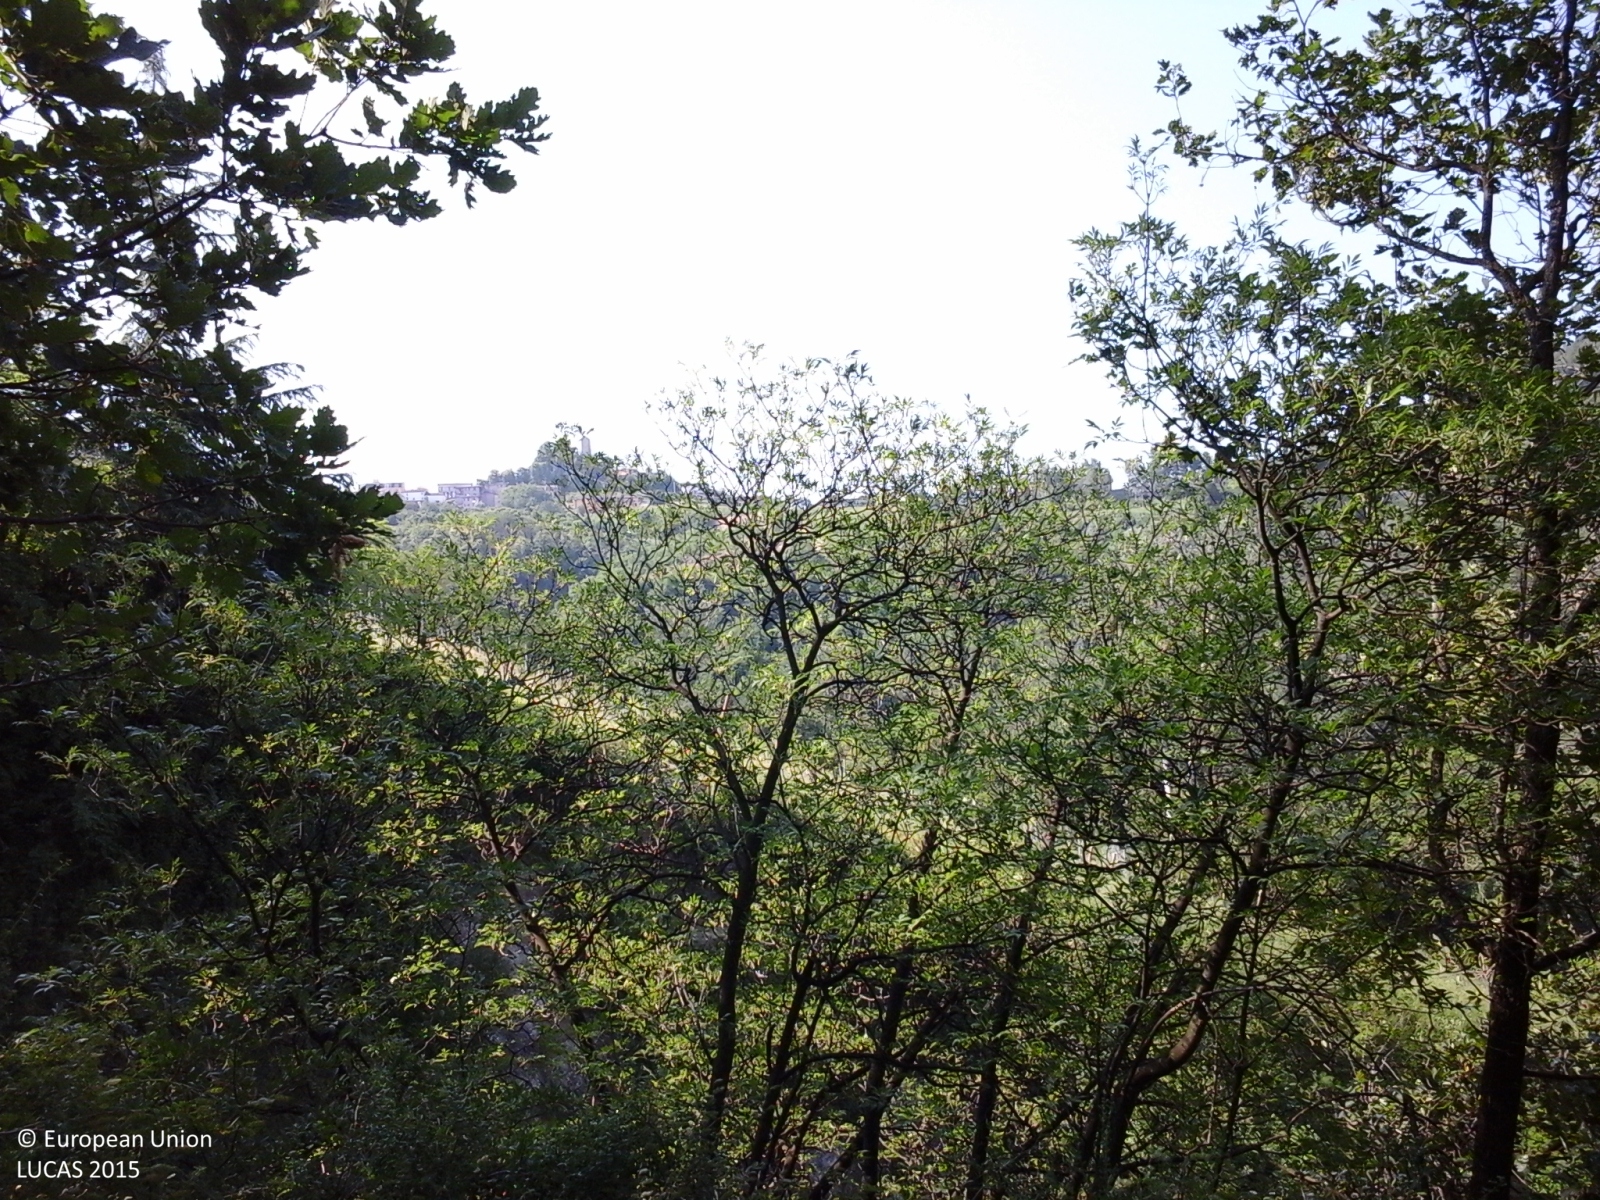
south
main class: Woodland
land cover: Broadleaved woodland
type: mesophytic deciduous forest
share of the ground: > 75 %
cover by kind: broadleaved forest trees 95 %, shrubs 5 %
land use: Forestry
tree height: > 5 m
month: June
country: IT
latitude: 44.6974
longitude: 8.2998
